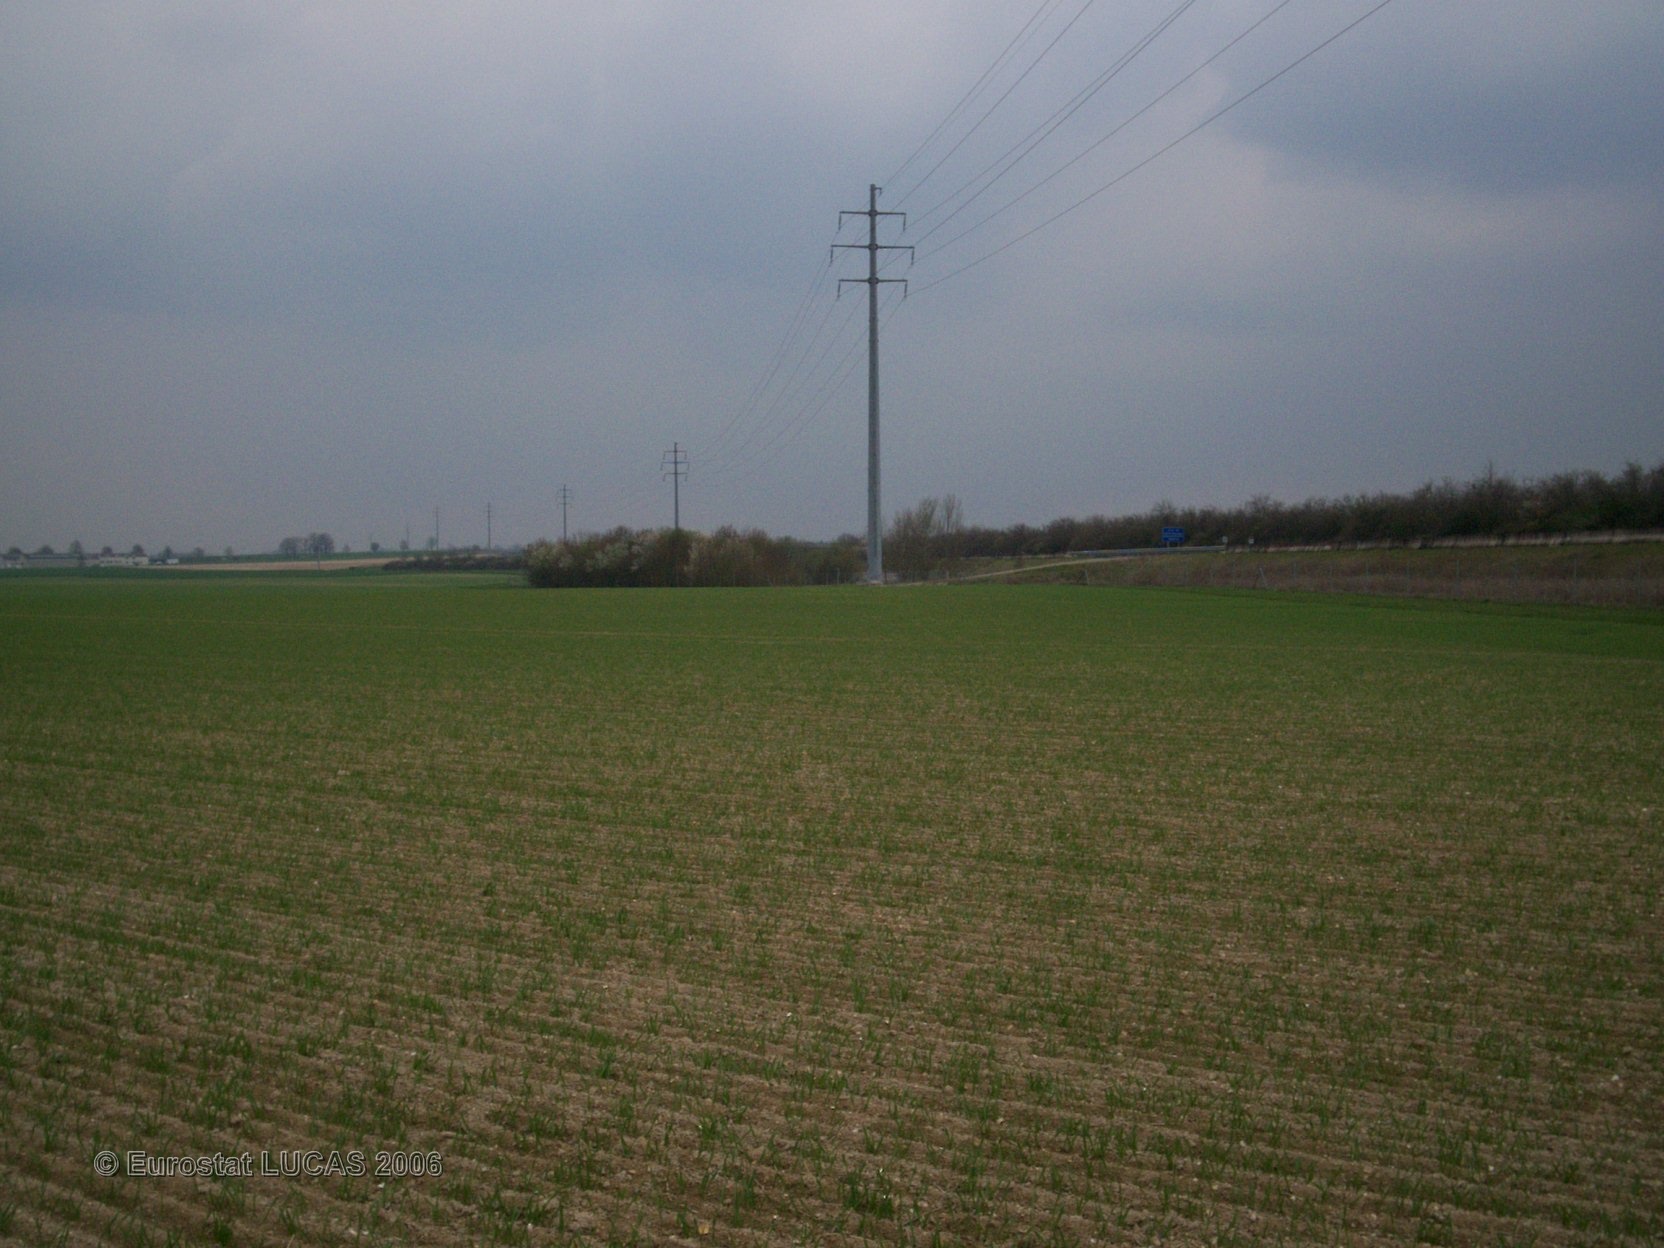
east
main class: Cropland
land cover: Barley
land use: Agriculture (excluding fallow land and kitchen gardens)
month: April
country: FR
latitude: 48.2408
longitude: 4.0042
